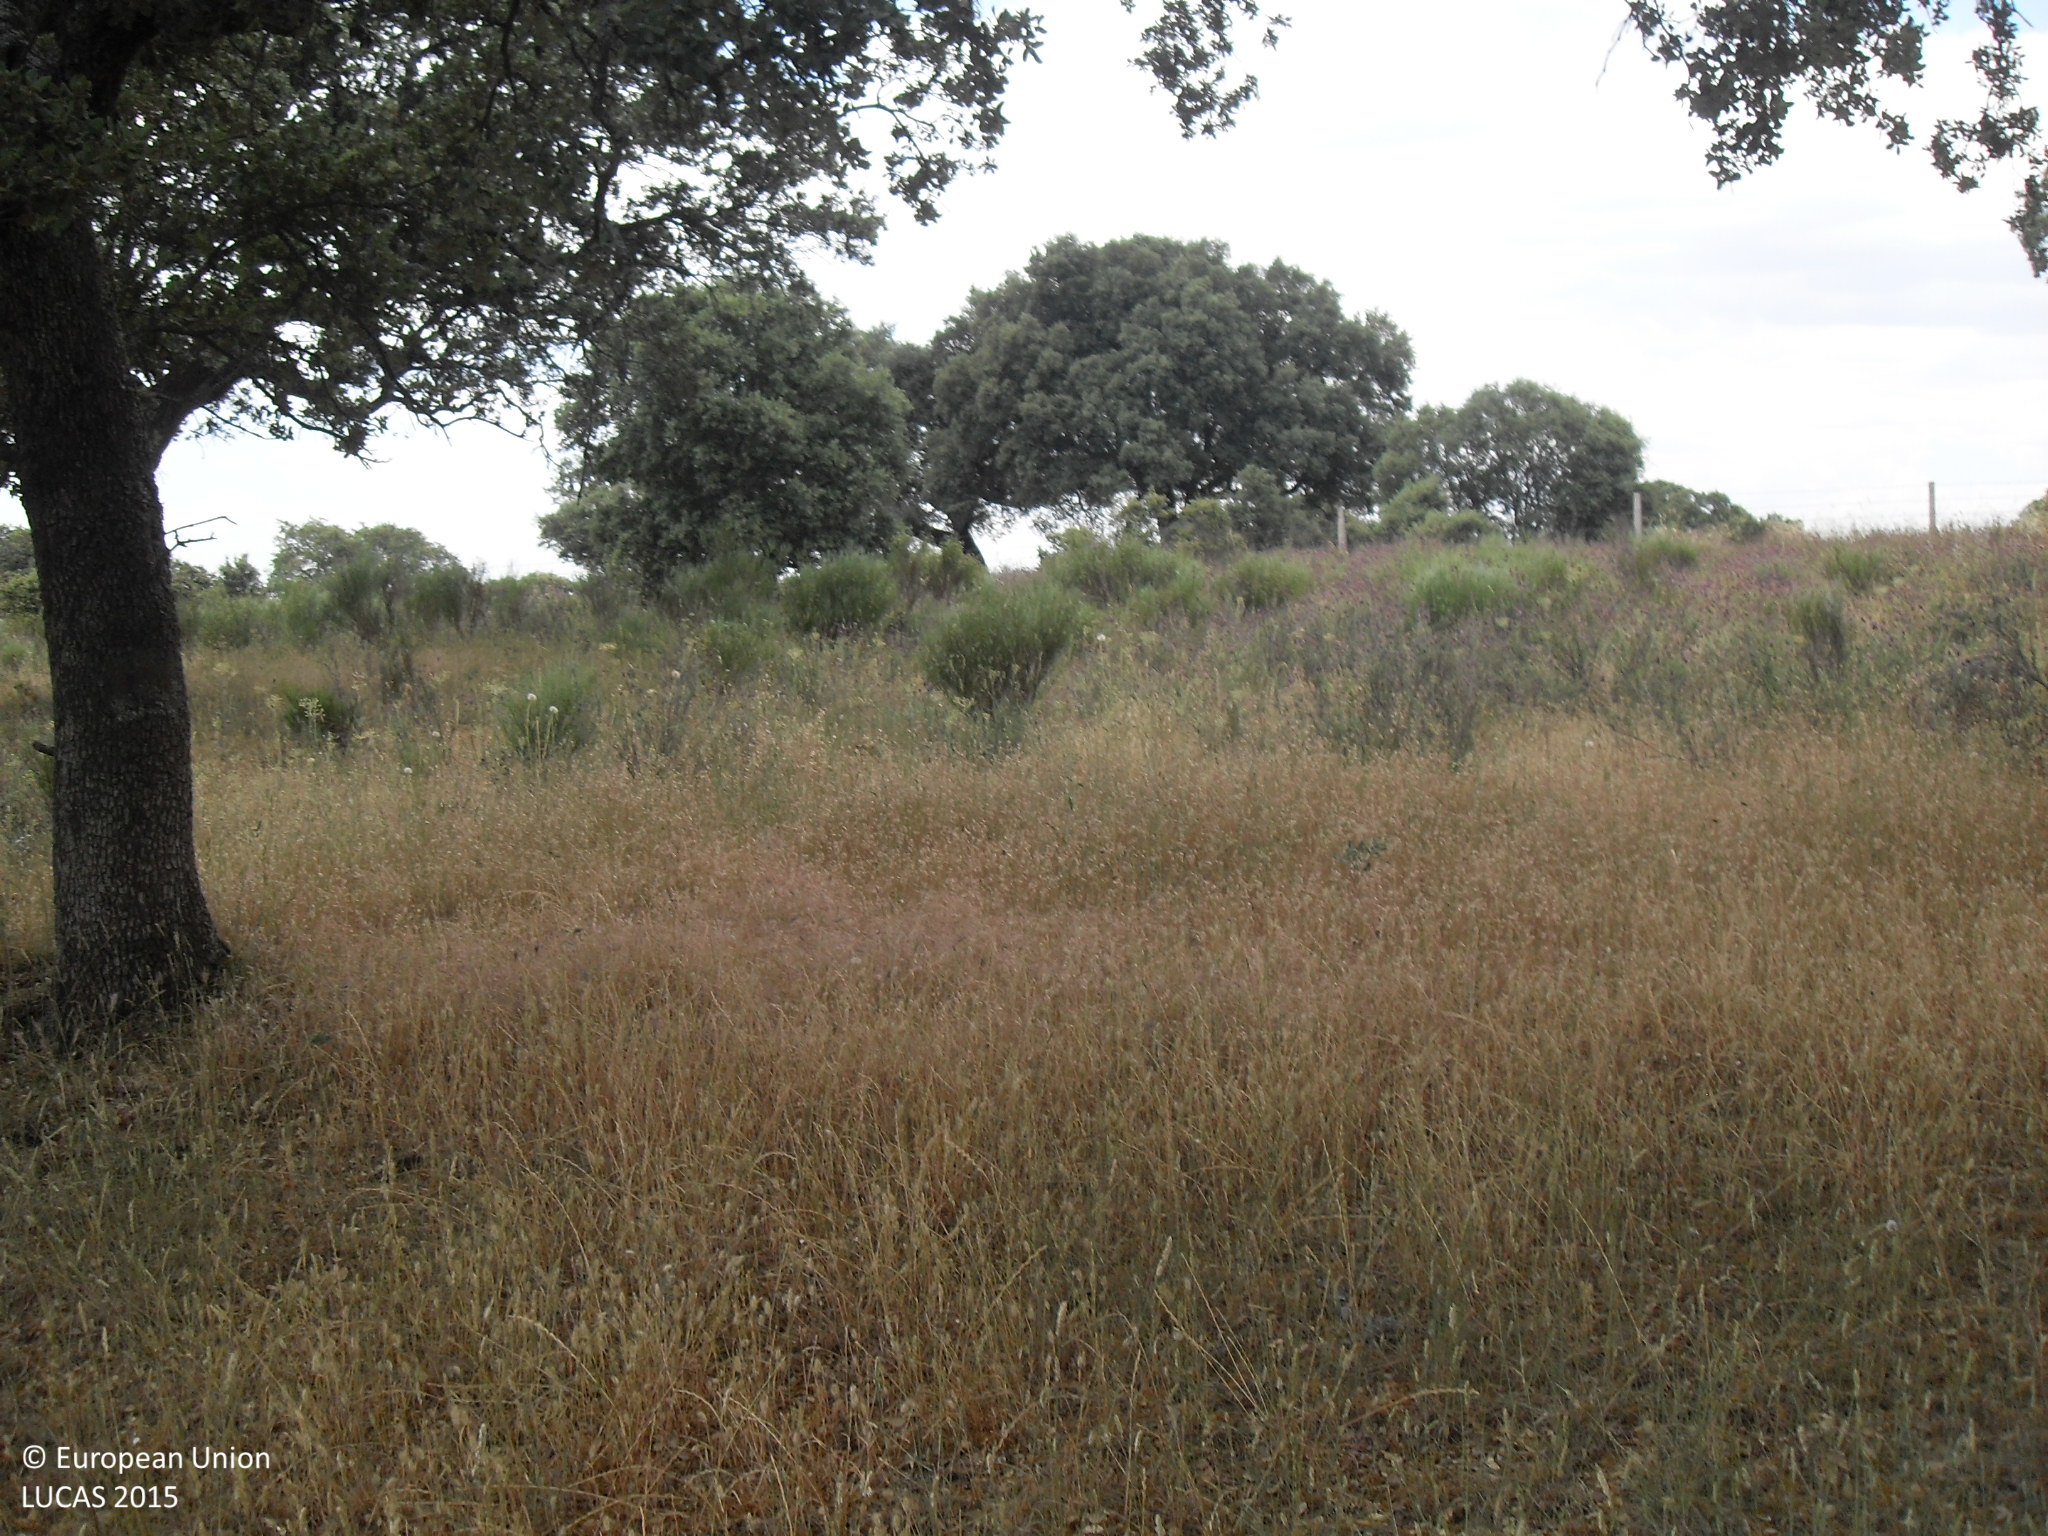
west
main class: Woodland
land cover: Broadleaved woodland
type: broadleaved evergreen forest
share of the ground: 25 - 50 %
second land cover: Grassland without tree/shrub cover
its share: 50 - 75 %
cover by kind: herbaceous plants 65 %, broadleaved forest trees 35 %
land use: Forestry
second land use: Agriculture (excluding fallow land and kitchen gardens)
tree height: > 5 m
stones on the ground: < 10 %
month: June
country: ES
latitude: 40.5095
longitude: -5.5399
